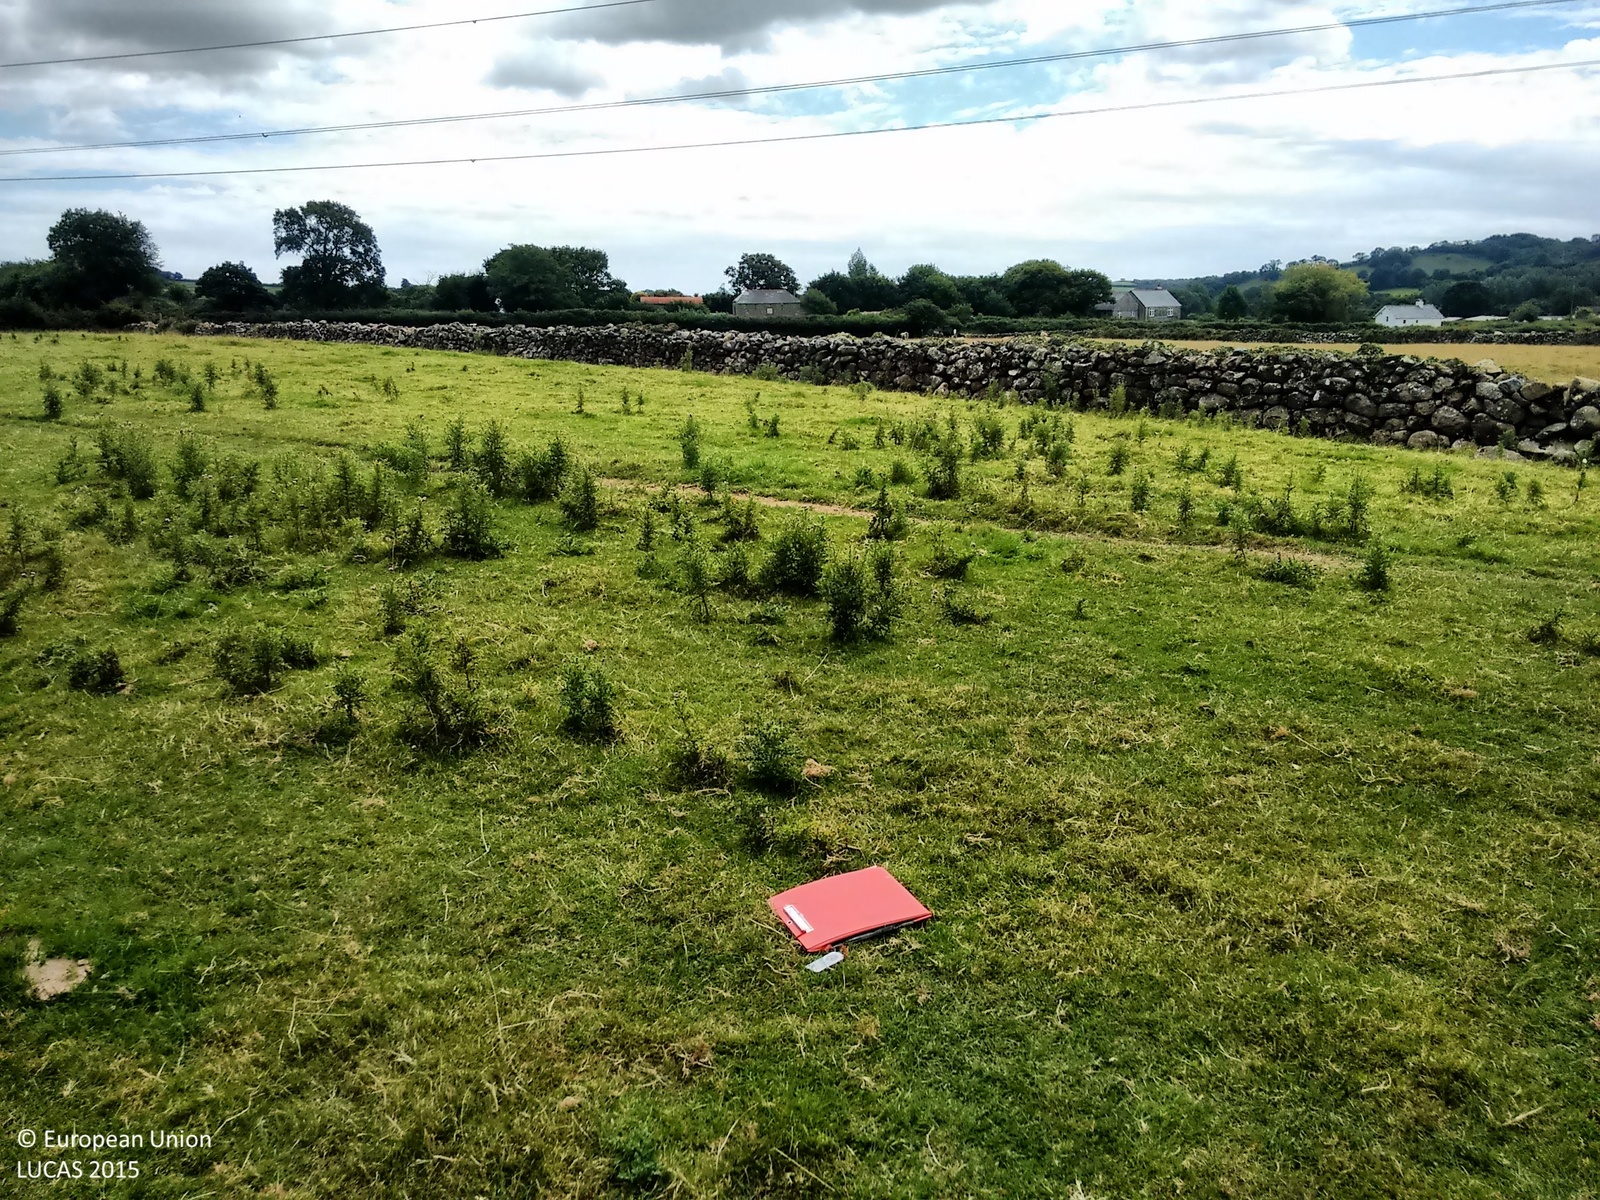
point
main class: Grassland
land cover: Grassland without tree/shrub cover
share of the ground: > 75 %
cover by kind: herbaceous plants 100 %
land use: Agriculture (excluding fallow land and kitchen gardens)
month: August
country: GB
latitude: 50.3841
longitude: -3.9165
